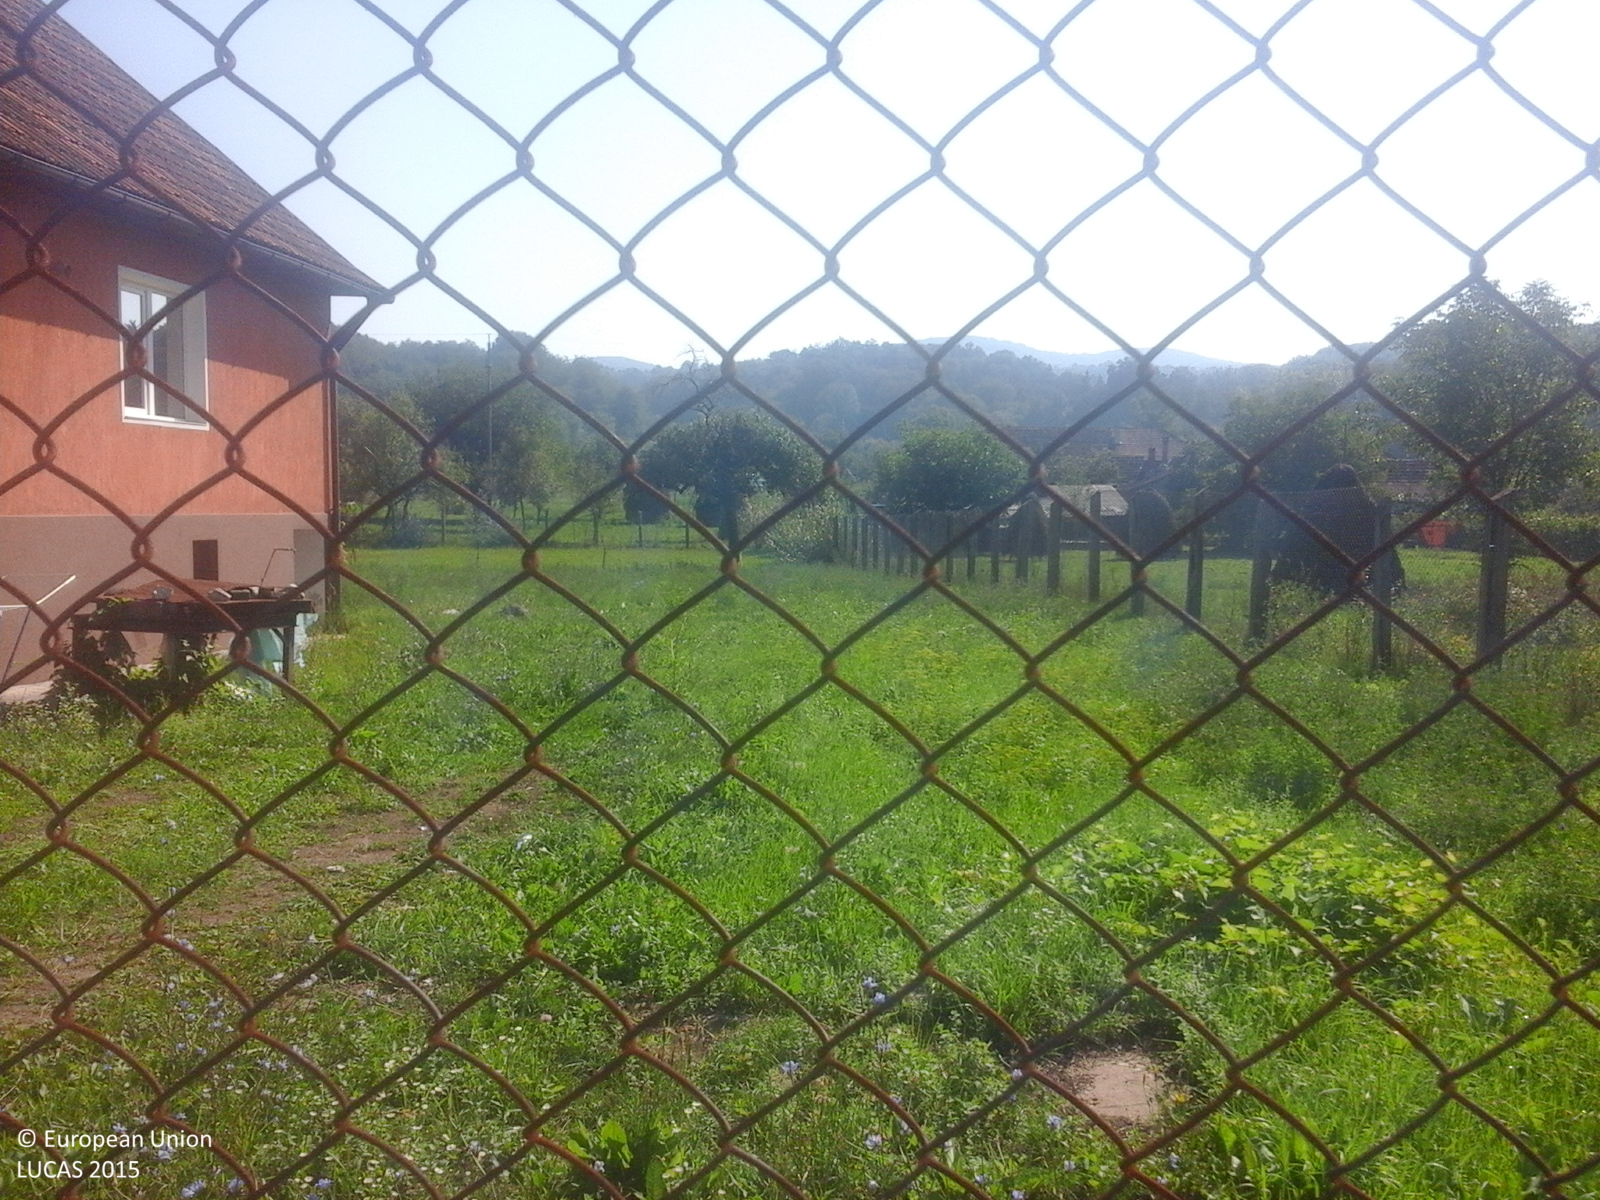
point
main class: Grassland
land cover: Grassland without tree/shrub cover
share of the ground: > 75 %
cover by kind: herbaceous plants 100 %
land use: Agriculture (excluding fallow land and kitchen gardens)
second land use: Residential
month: August
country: RO
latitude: 46.0467
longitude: 22.3889
